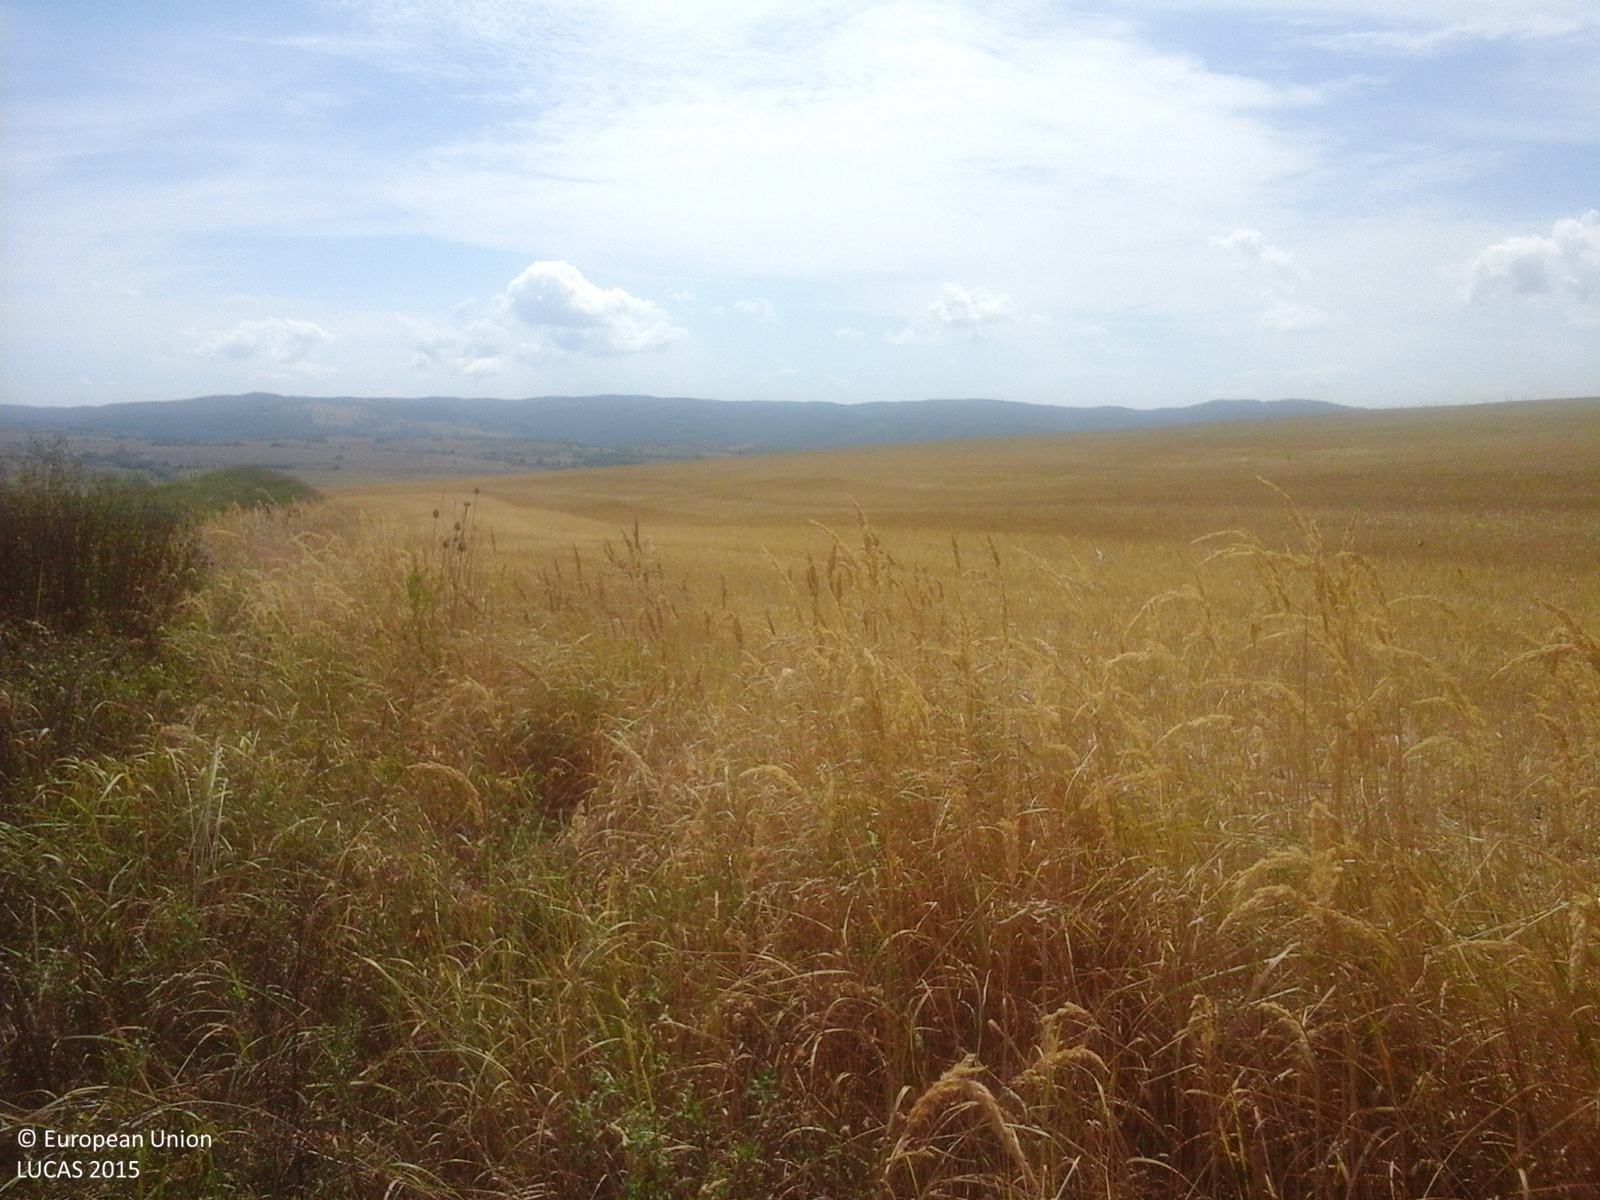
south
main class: Grassland
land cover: Spontaneously vegetated surfaces
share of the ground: > 75 %
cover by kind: herbaceous plants 100 %
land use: Fallow land
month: August
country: RO
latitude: 44.9205
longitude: 21.5704
